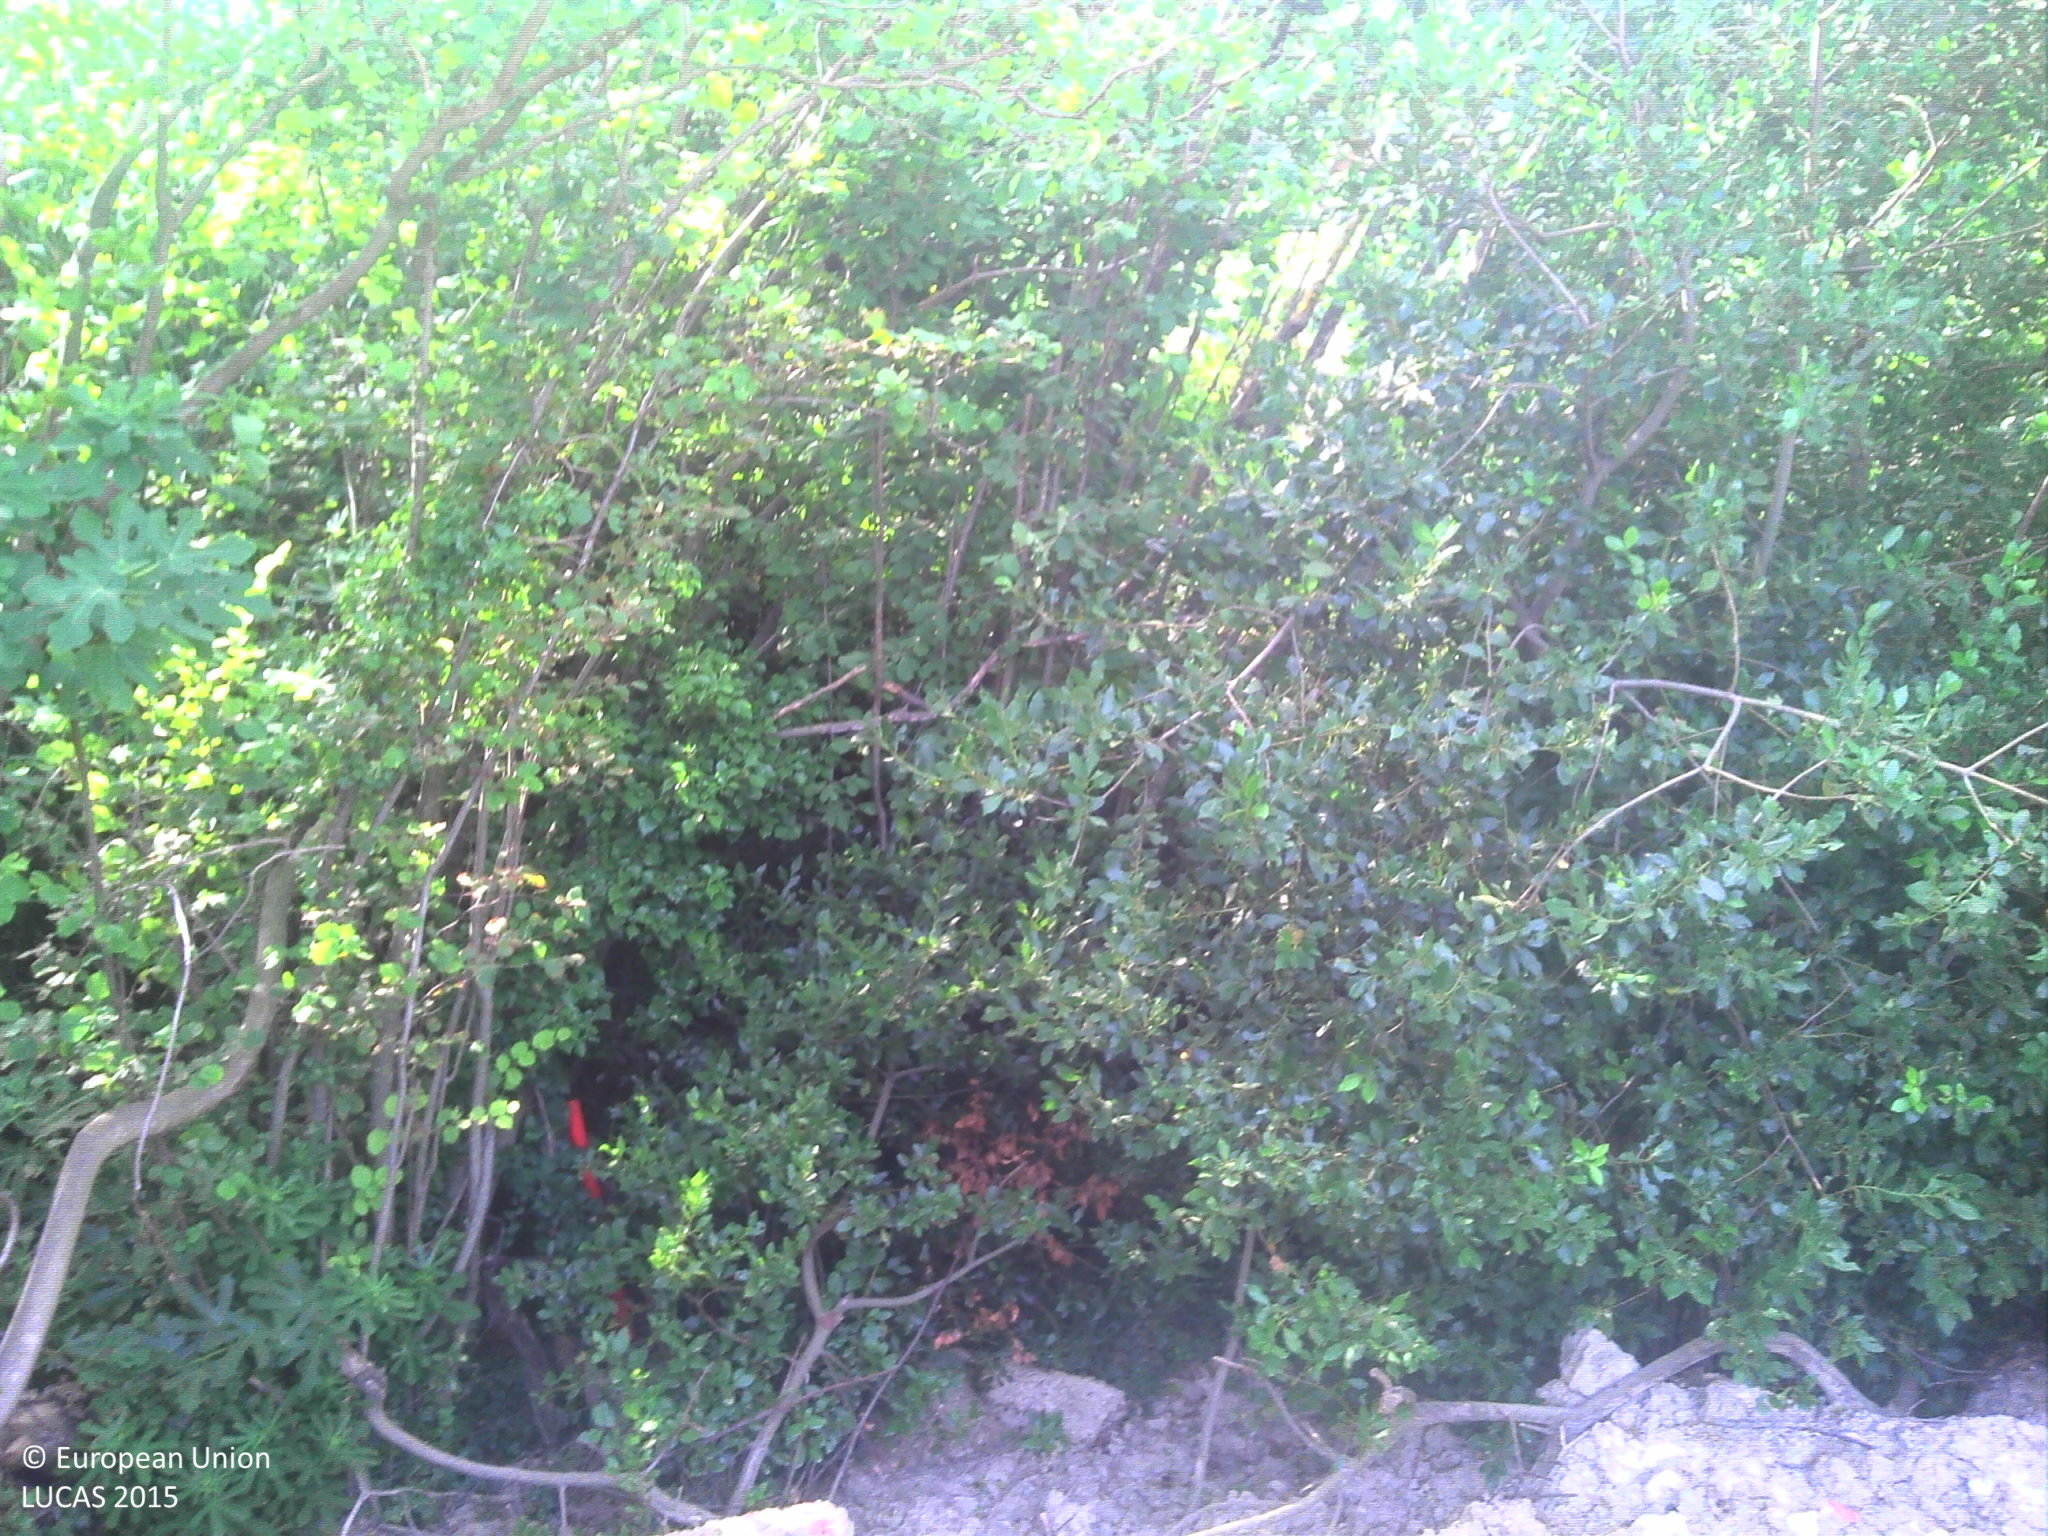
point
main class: Woodland
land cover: Broadleaved woodland
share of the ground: > 75 %
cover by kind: broadleaved forest trees 80 %
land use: Semi-natural and natural areas not in use
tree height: < 5 m
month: July
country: FR
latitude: 43.6176
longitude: 5.0406
